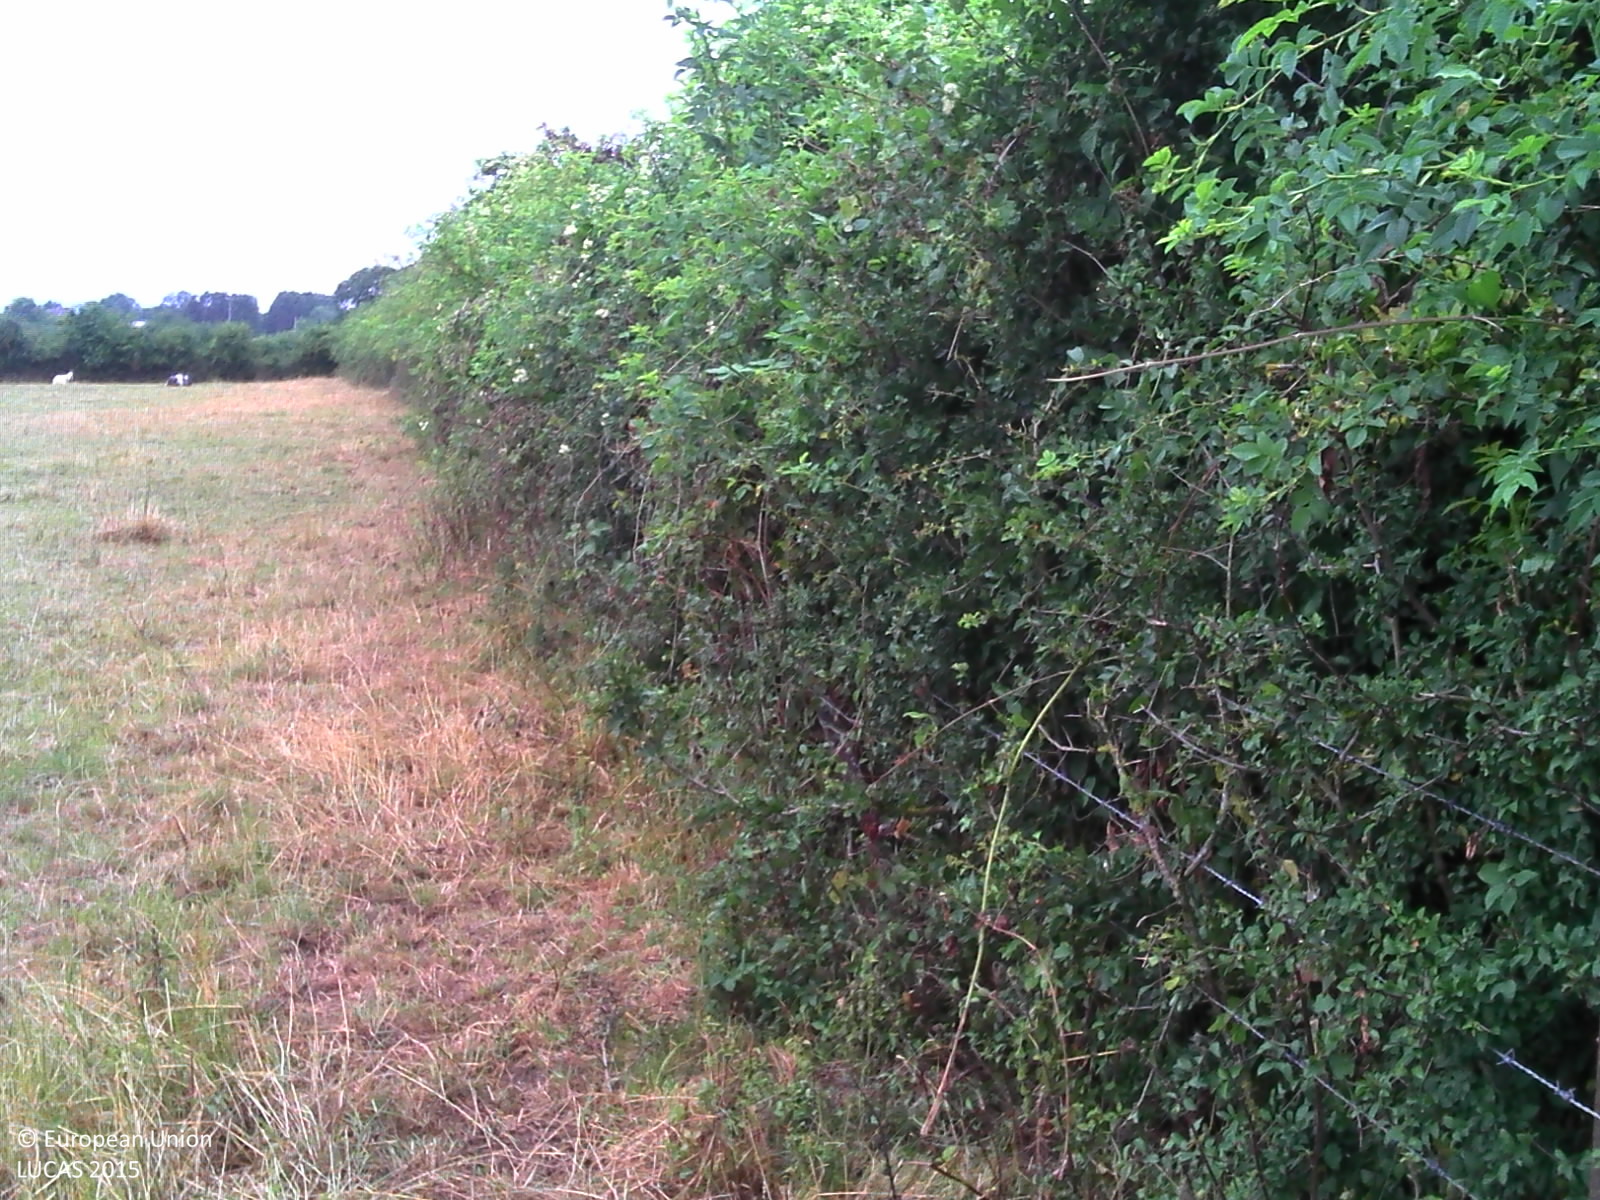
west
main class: Grassland
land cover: Grassland without tree/shrub cover
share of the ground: > 75 %
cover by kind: herbaceous plants 100 %
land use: Agriculture (excluding fallow land and kitchen gardens)
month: July
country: BE
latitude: 50.1840
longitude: 4.6325
